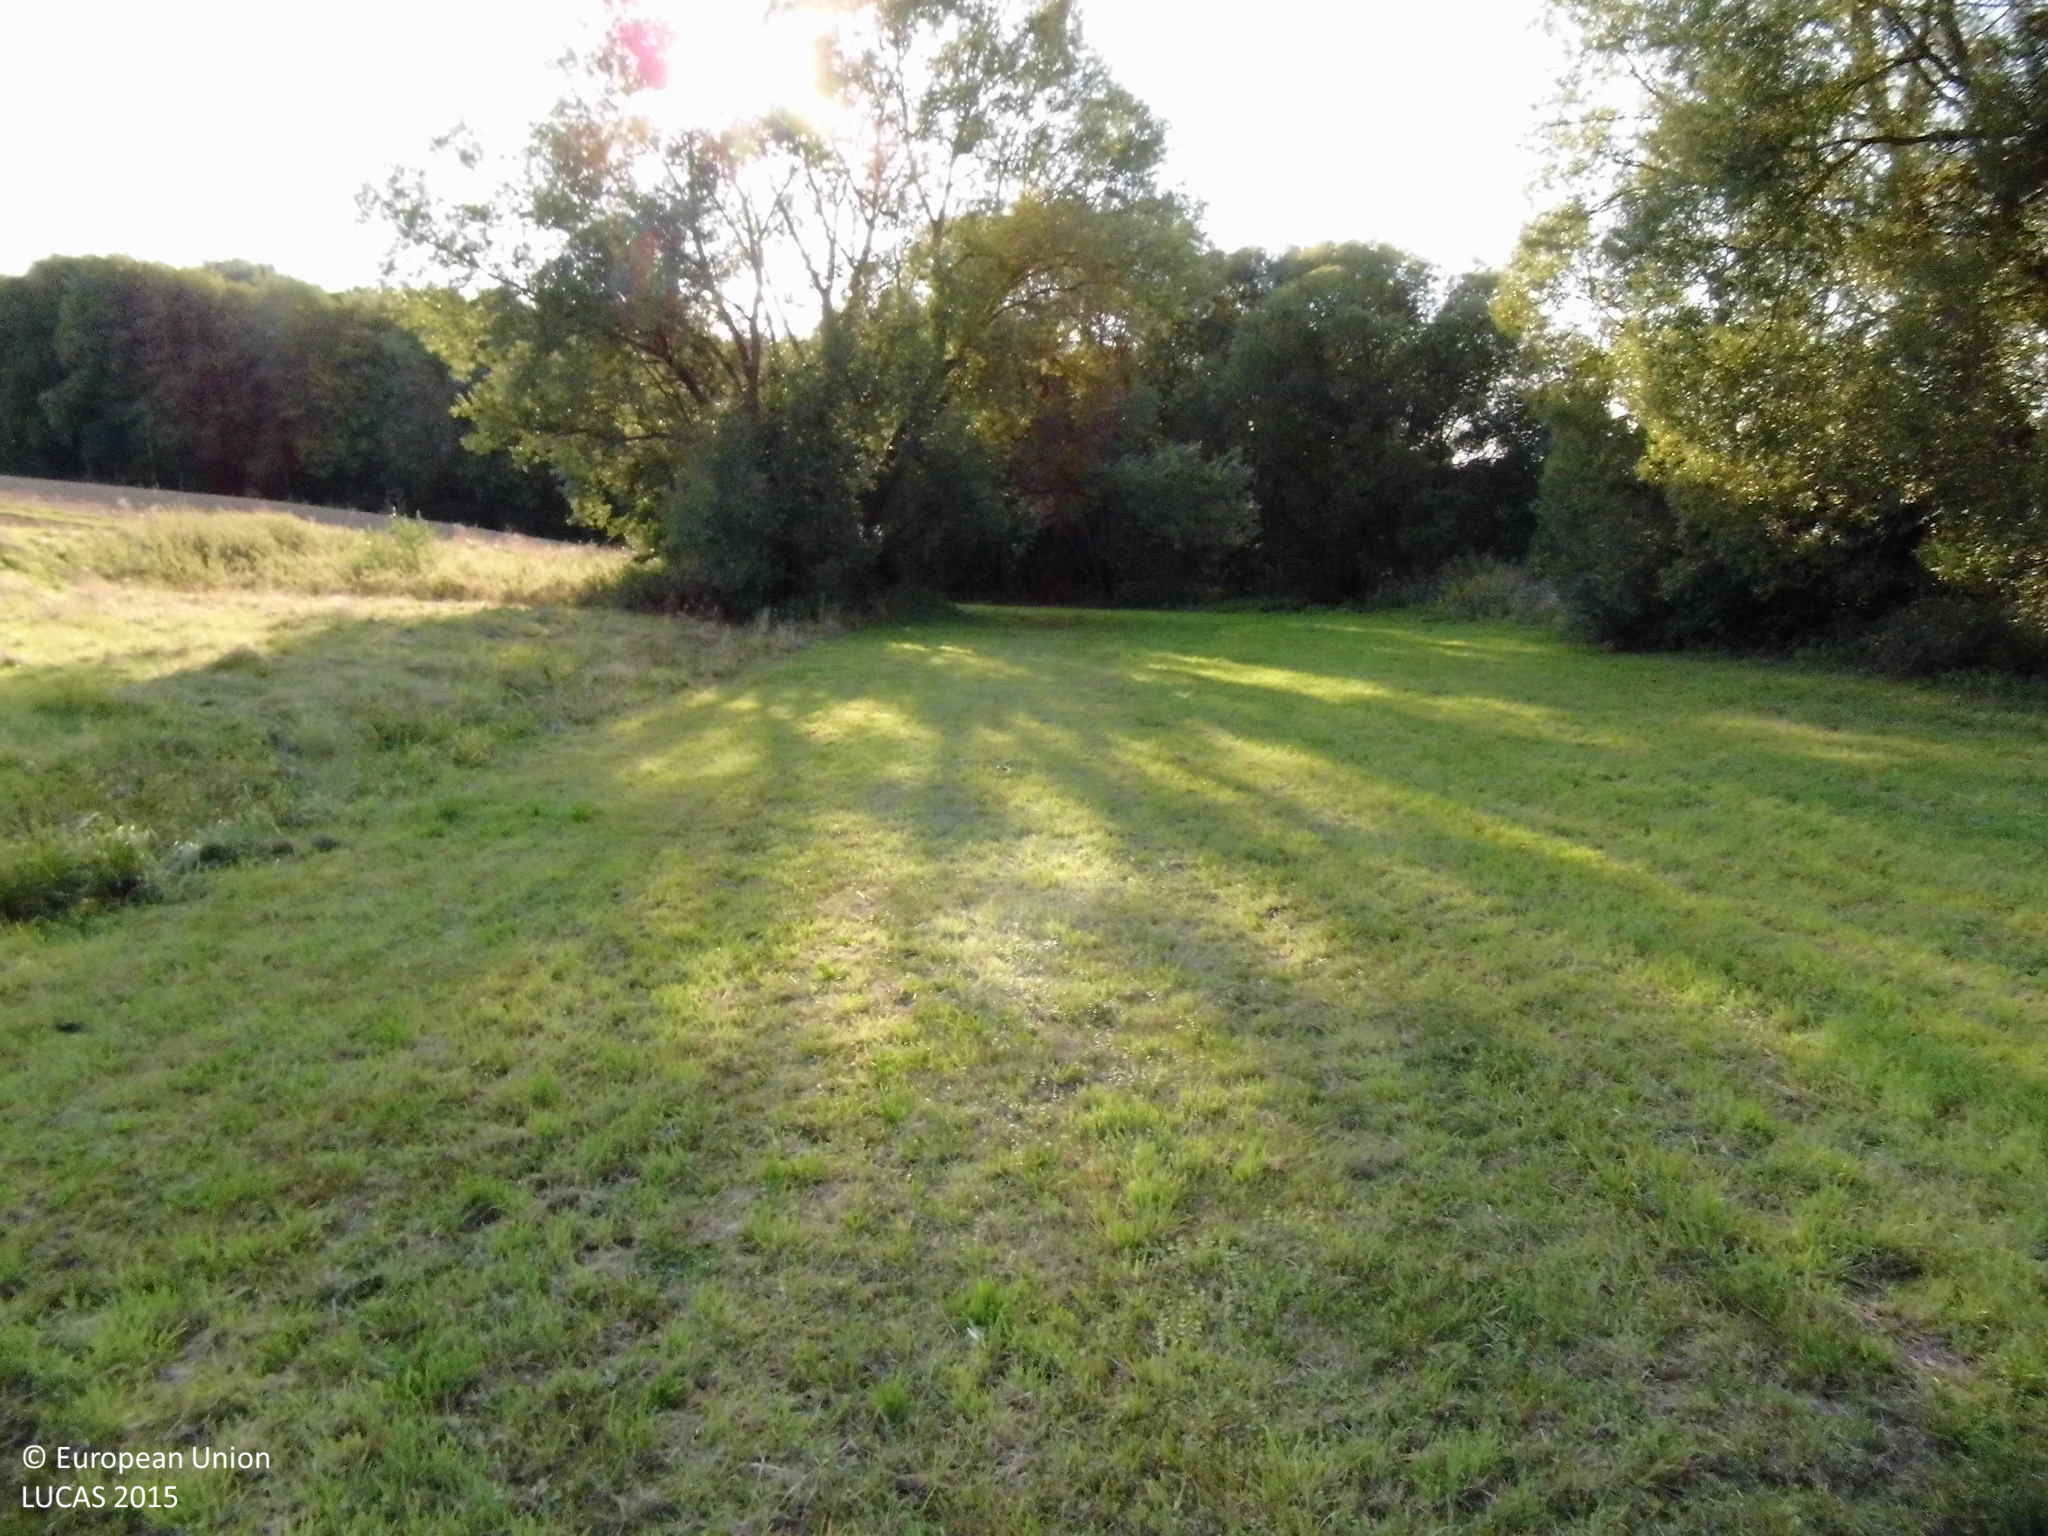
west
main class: Grassland
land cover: Grassland without tree/shrub cover
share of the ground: > 75 %
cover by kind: herbaceous plants 100 %
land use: Agriculture (excluding fallow land and kitchen gardens)
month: August
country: DE
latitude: 50.4008
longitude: 8.0167
